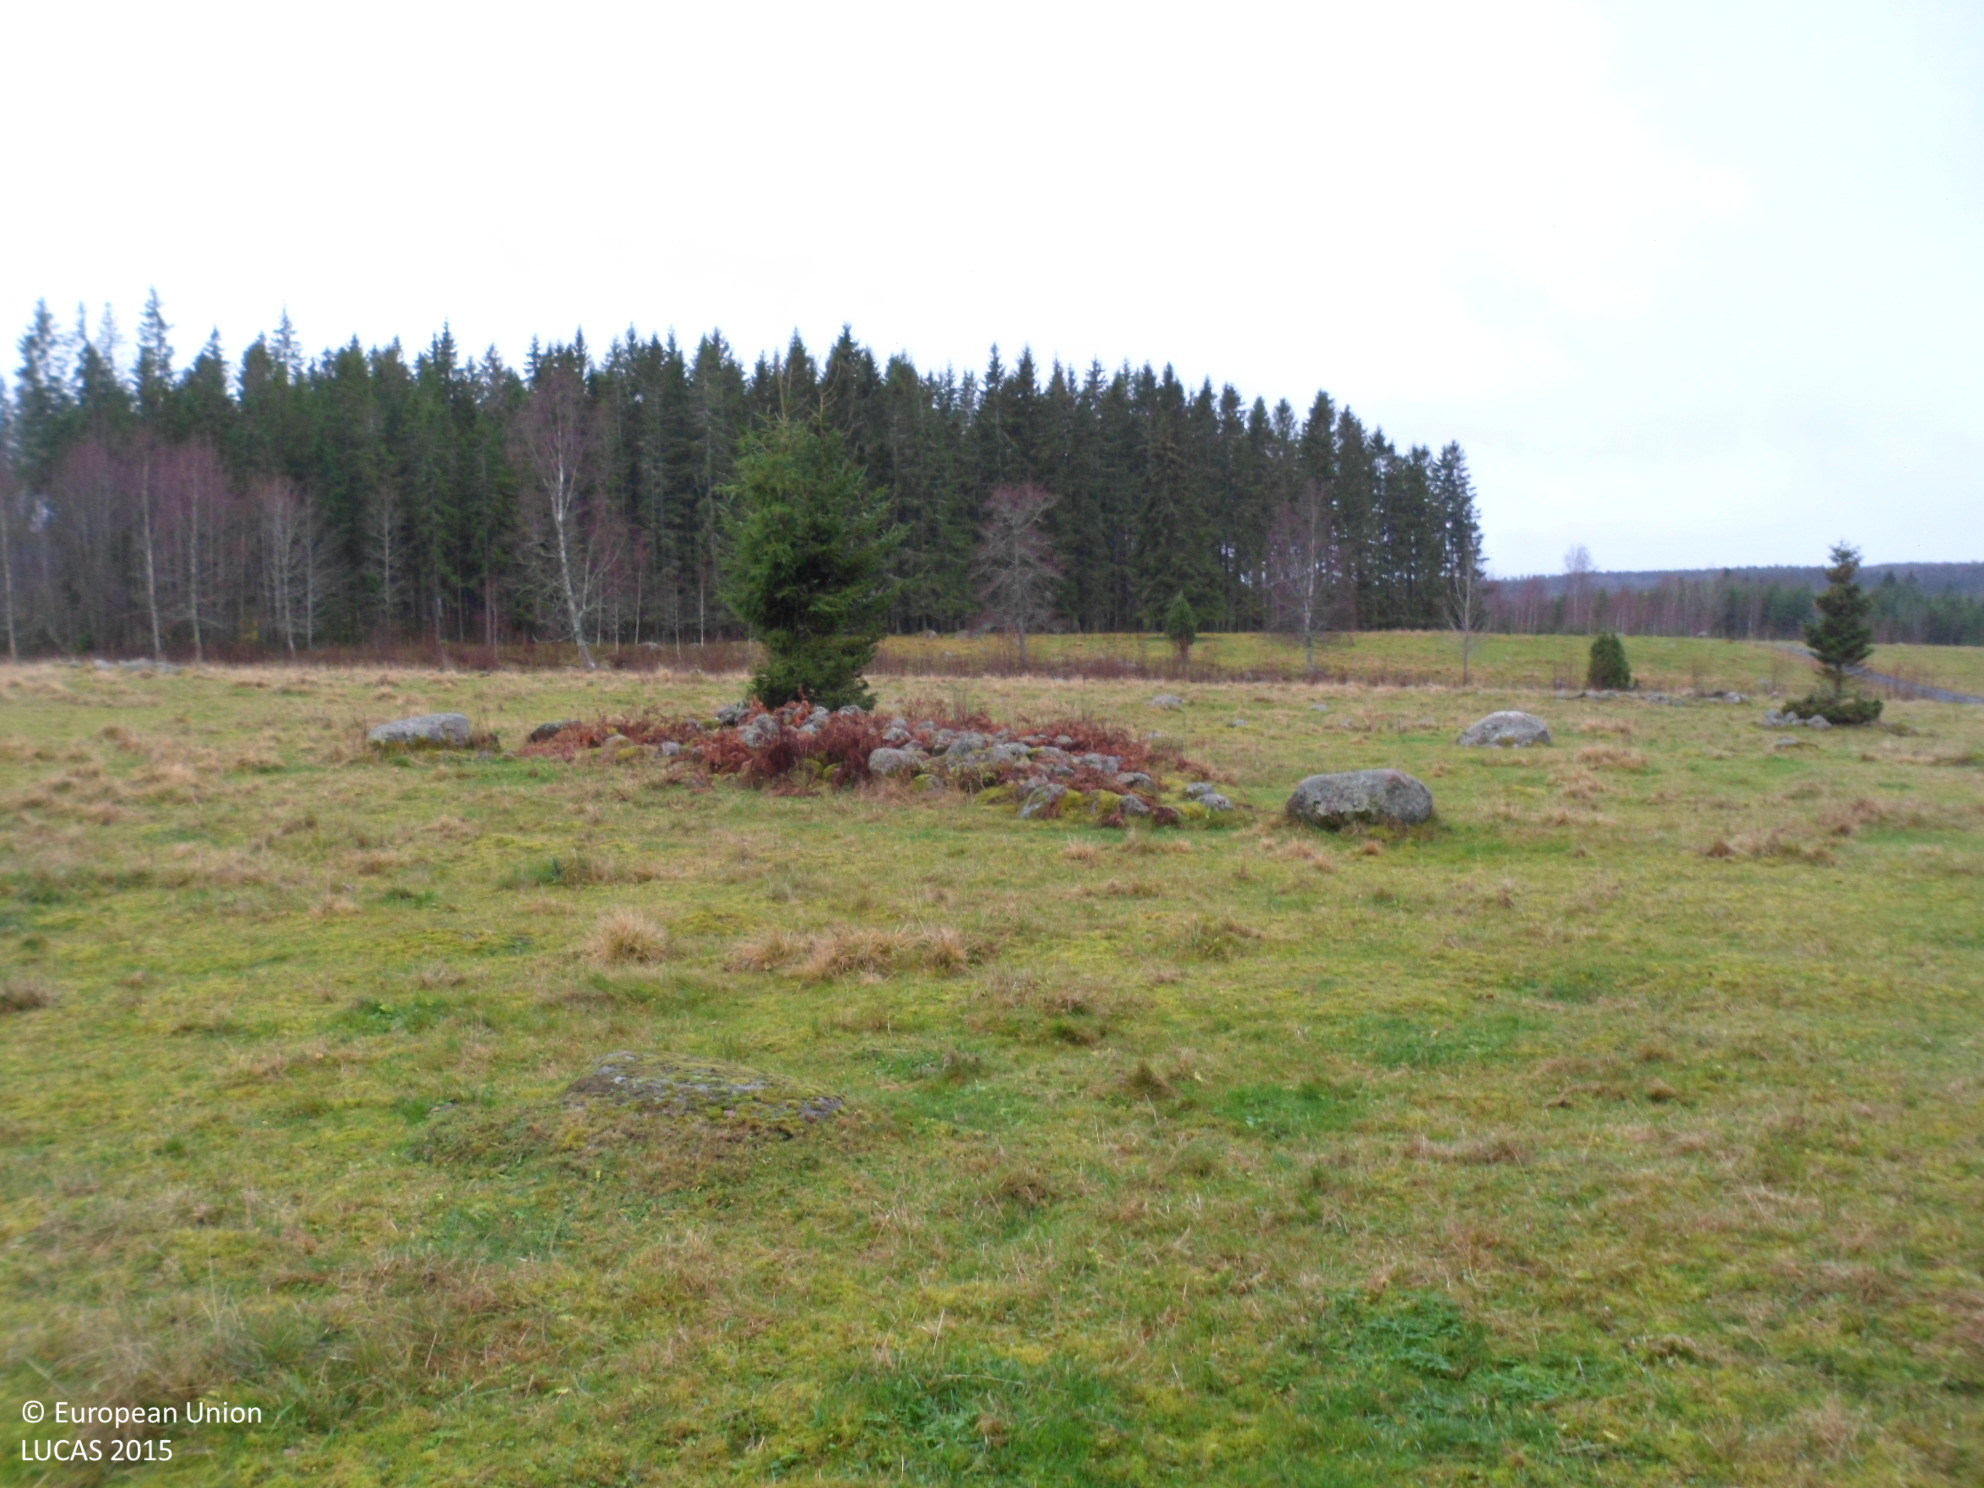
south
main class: Grassland
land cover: Grassland without tree/shrub cover
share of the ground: > 75 %
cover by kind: herbaceous plants 90 %, lichens and mosses 10 %
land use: Agriculture (excluding fallow land and kitchen gardens)
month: November
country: SE
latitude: 57.8086
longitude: 14.8253
